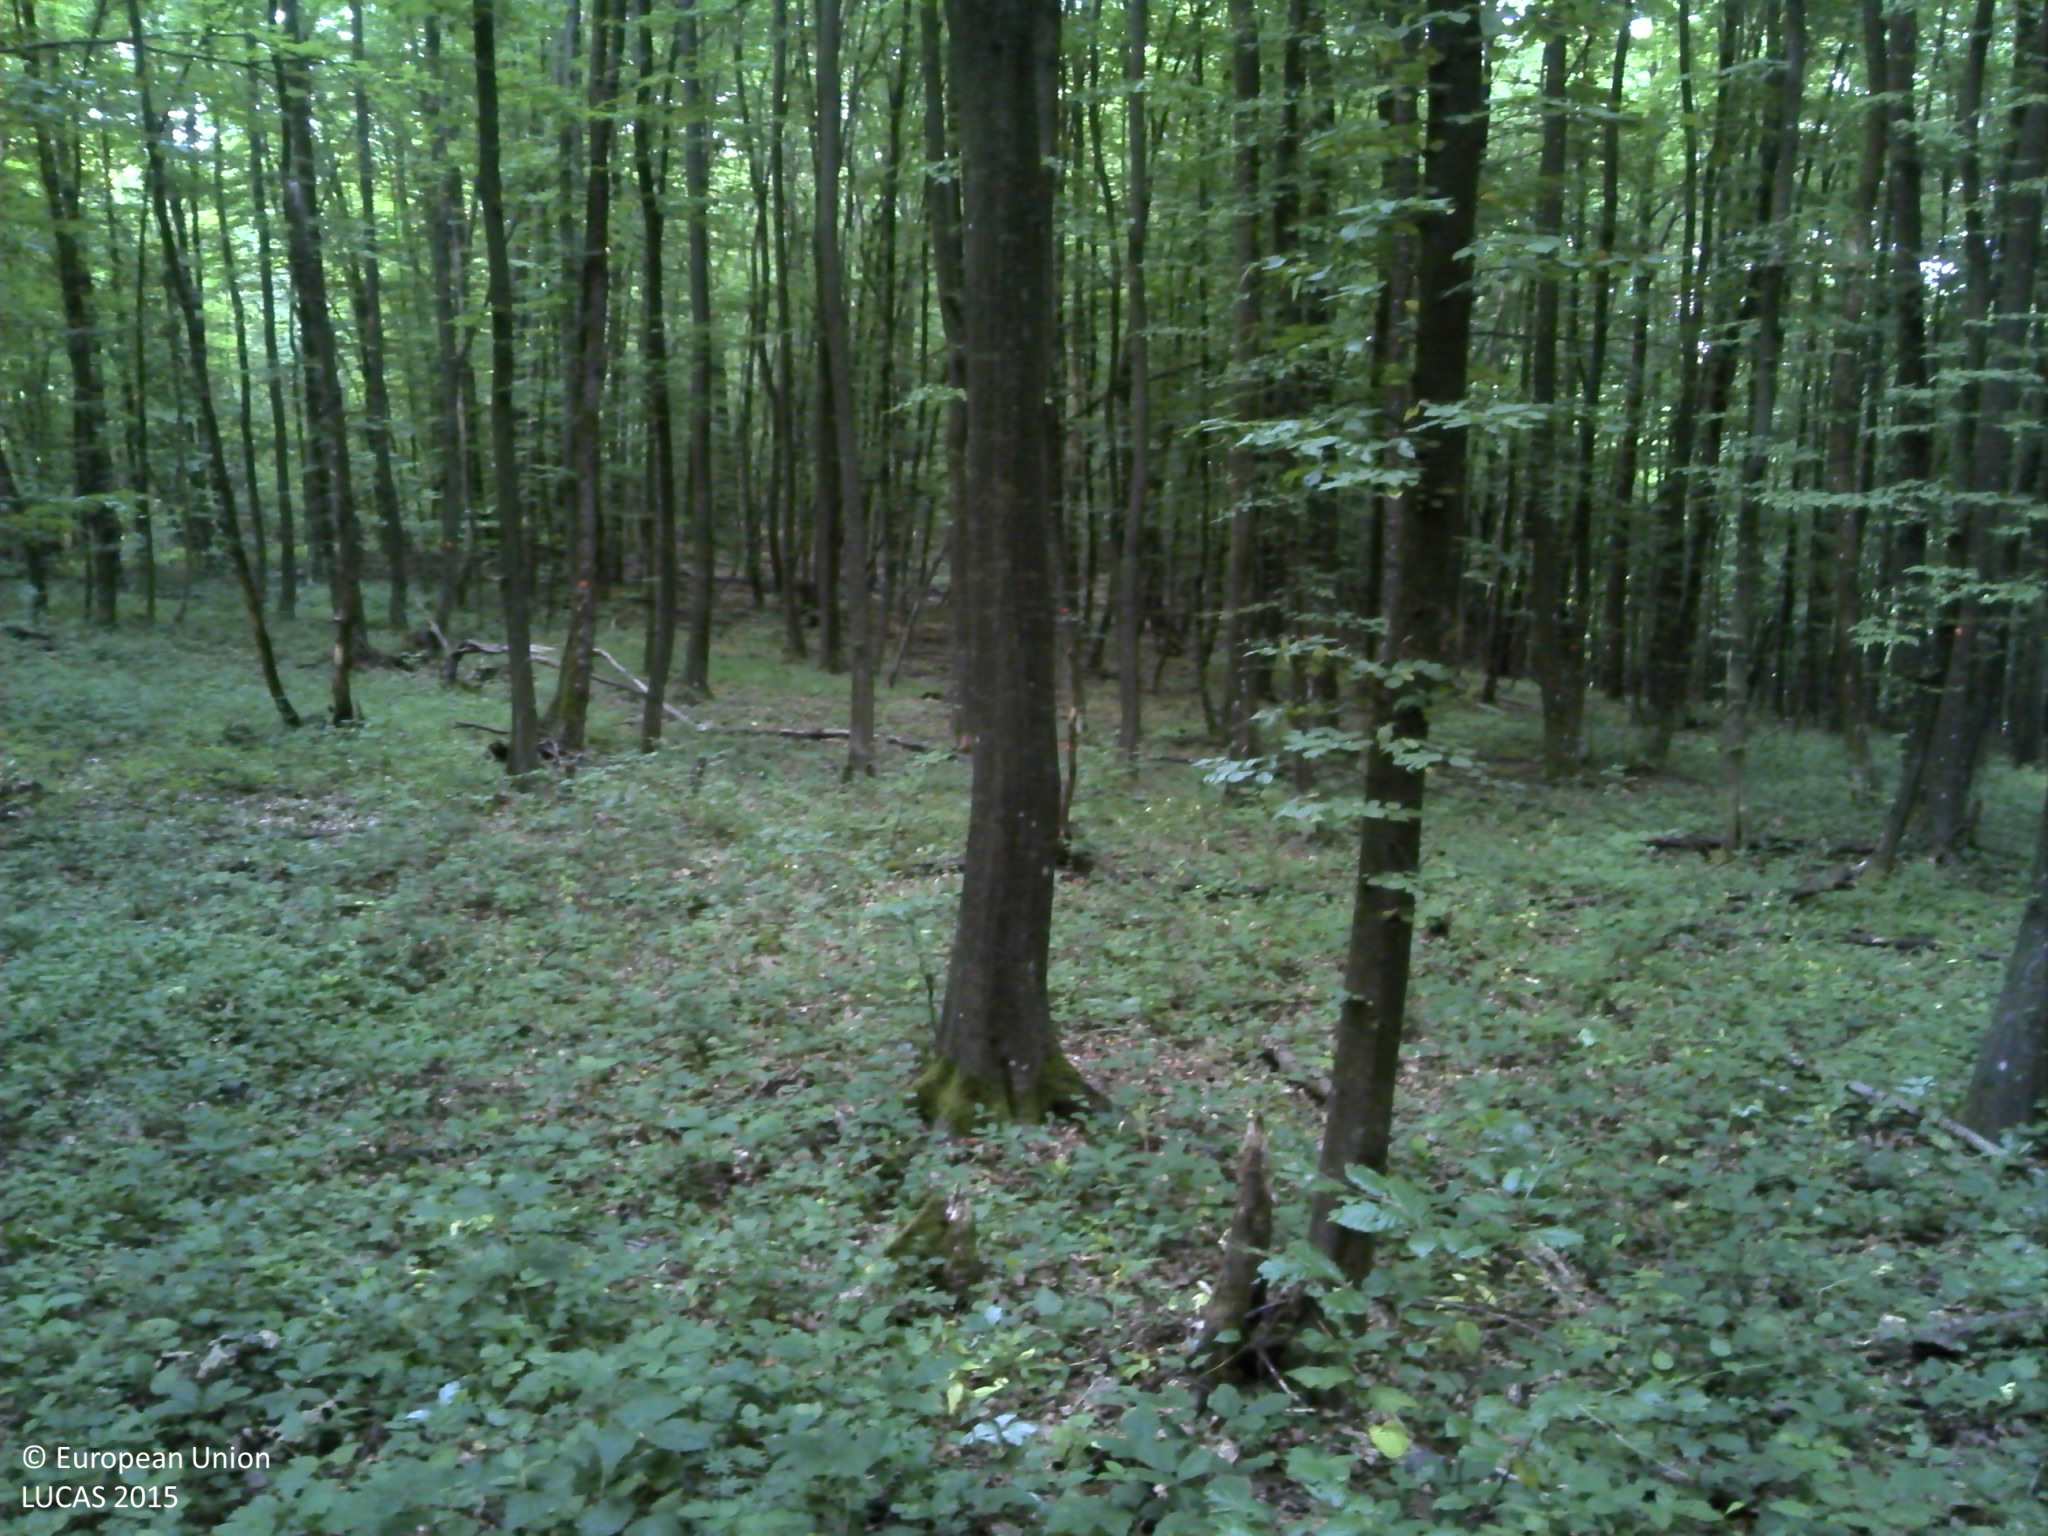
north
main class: Woodland
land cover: Broadleaved woodland
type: beech forest
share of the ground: > 75 %
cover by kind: broadleaved forest trees 90 %, herbaceous plants 5 %, lichens and mosses 5 %
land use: Forestry
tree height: > 5 m
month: June
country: HR
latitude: 45.2597
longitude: 18.1722
